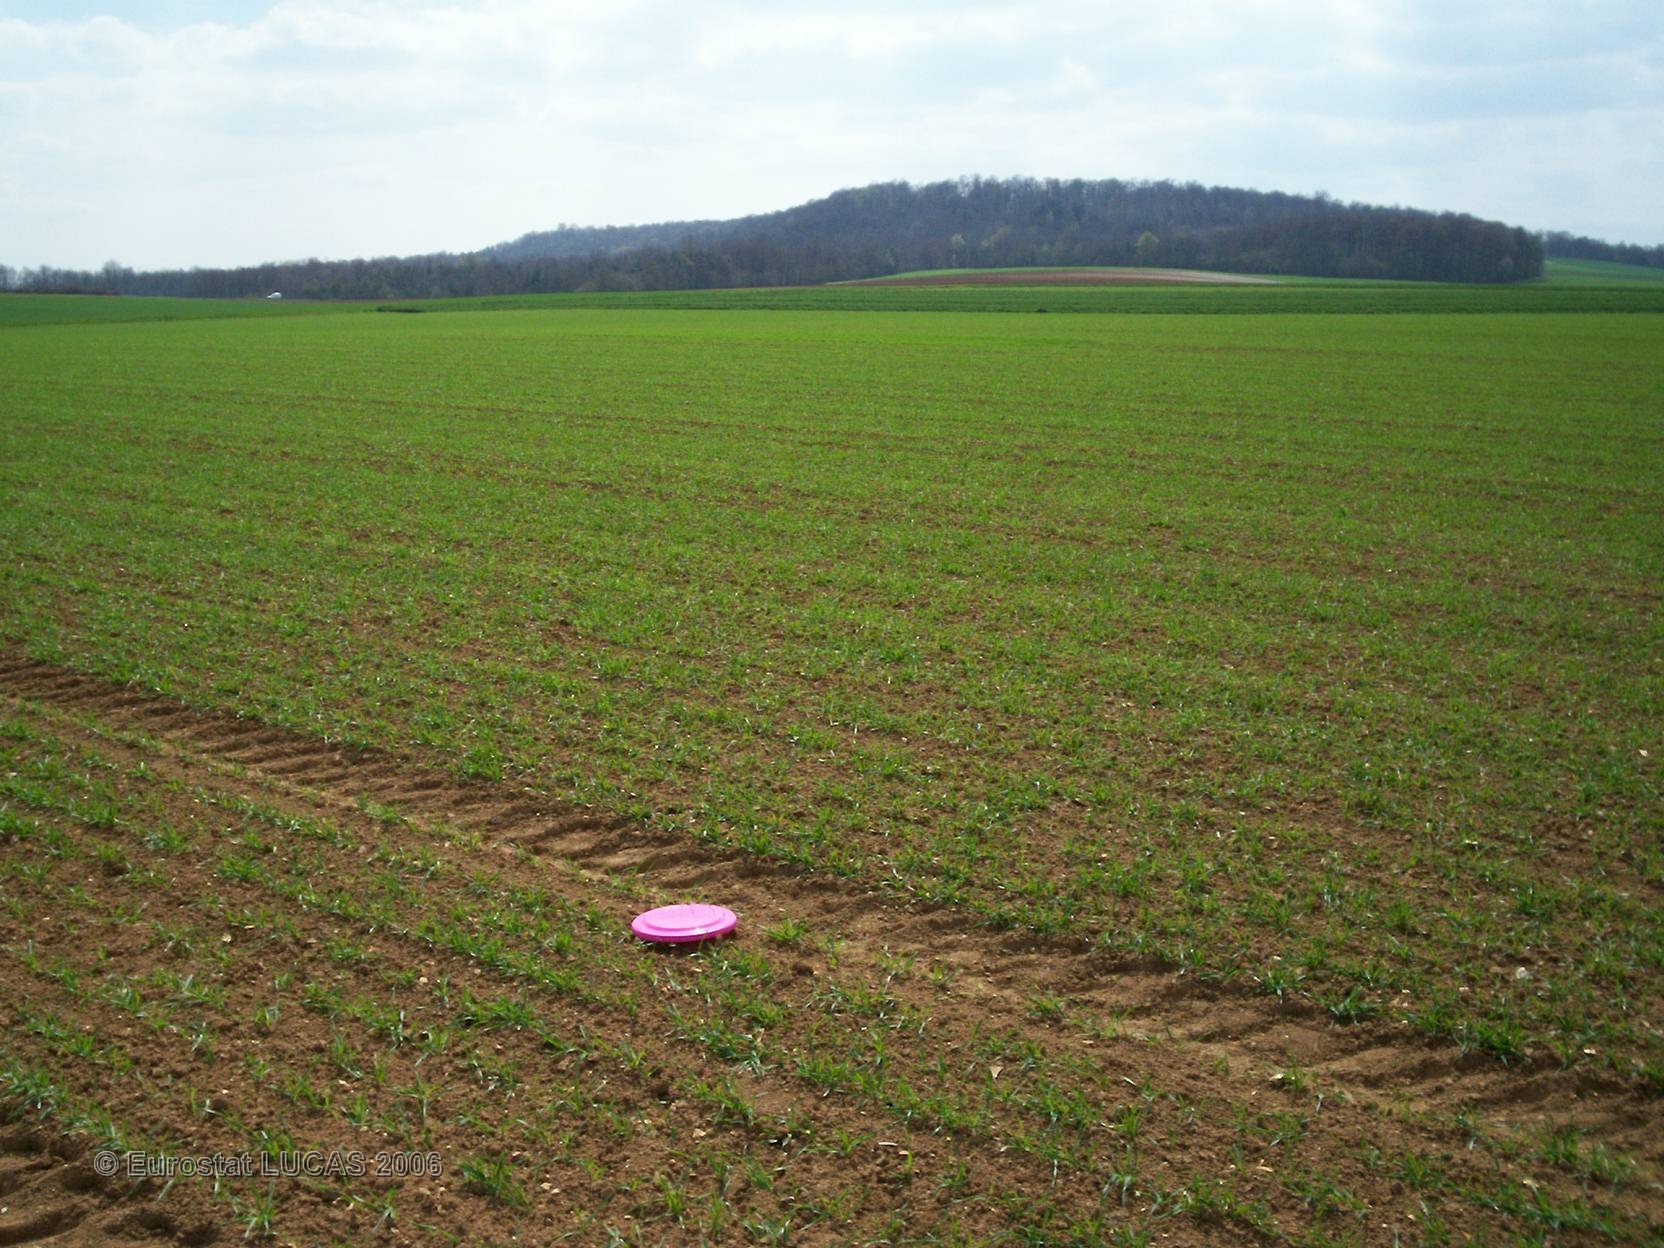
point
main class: Cropland
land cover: Barley
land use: Agriculture (excluding fallow land and kitchen gardens)
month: April
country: FR
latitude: 48.8666
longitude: 3.9013
